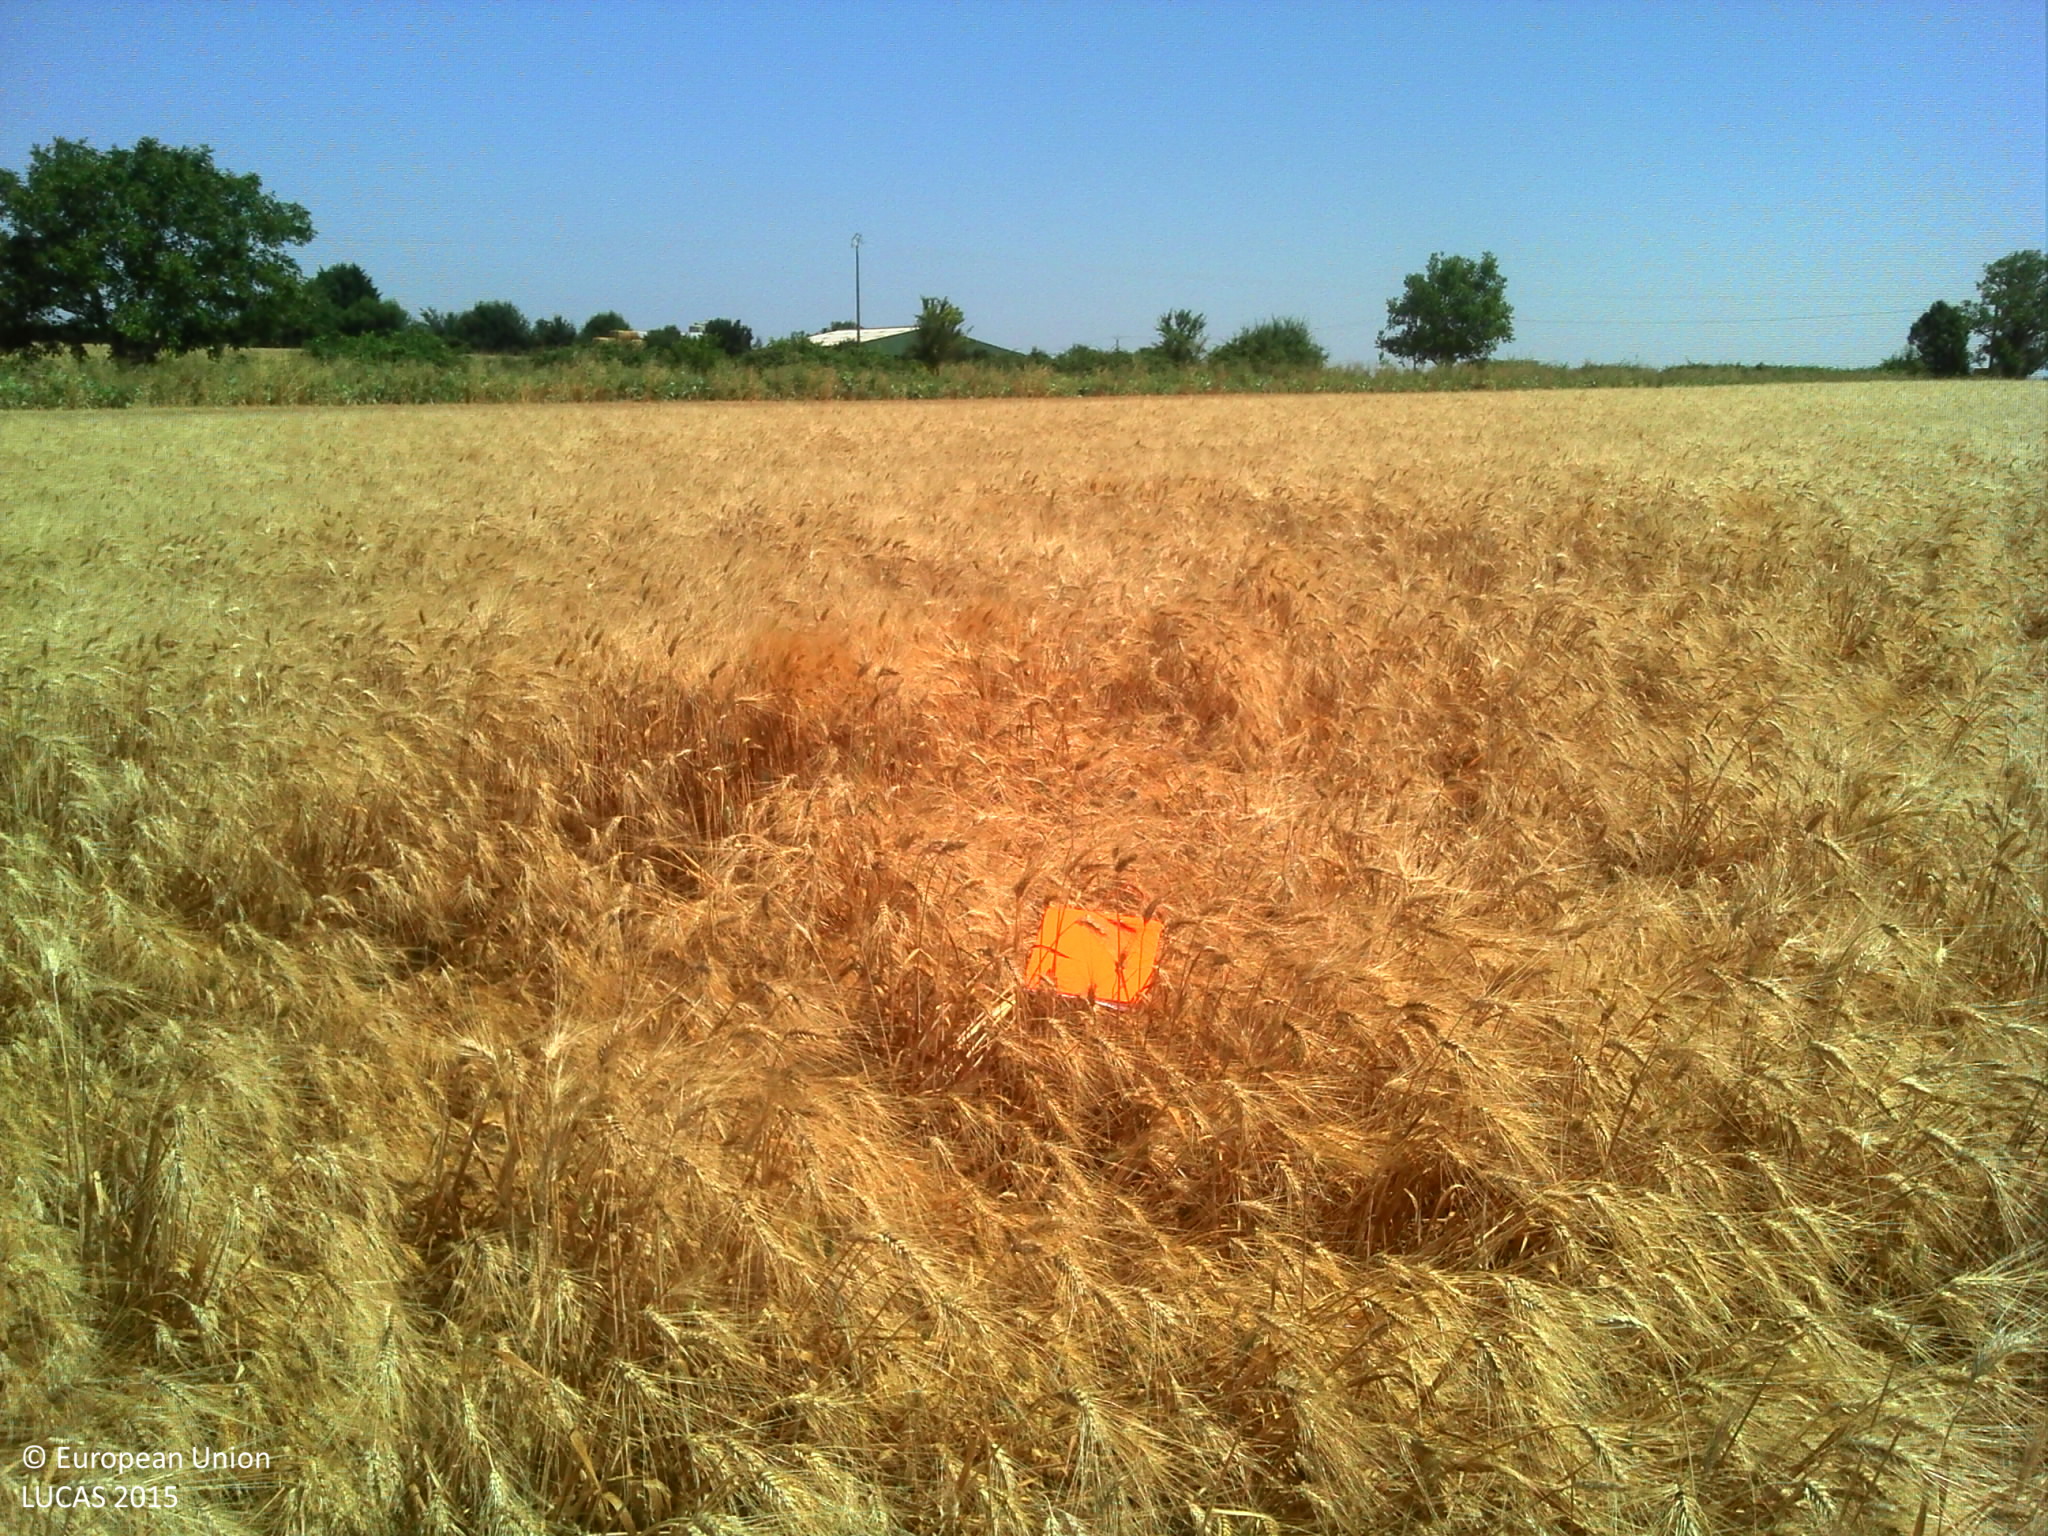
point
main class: Cropland
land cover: Common wheat
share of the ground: > 75 %
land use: Agriculture (excluding fallow land and kitchen gardens)
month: July
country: FR
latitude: 46.4595
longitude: -1.2979
